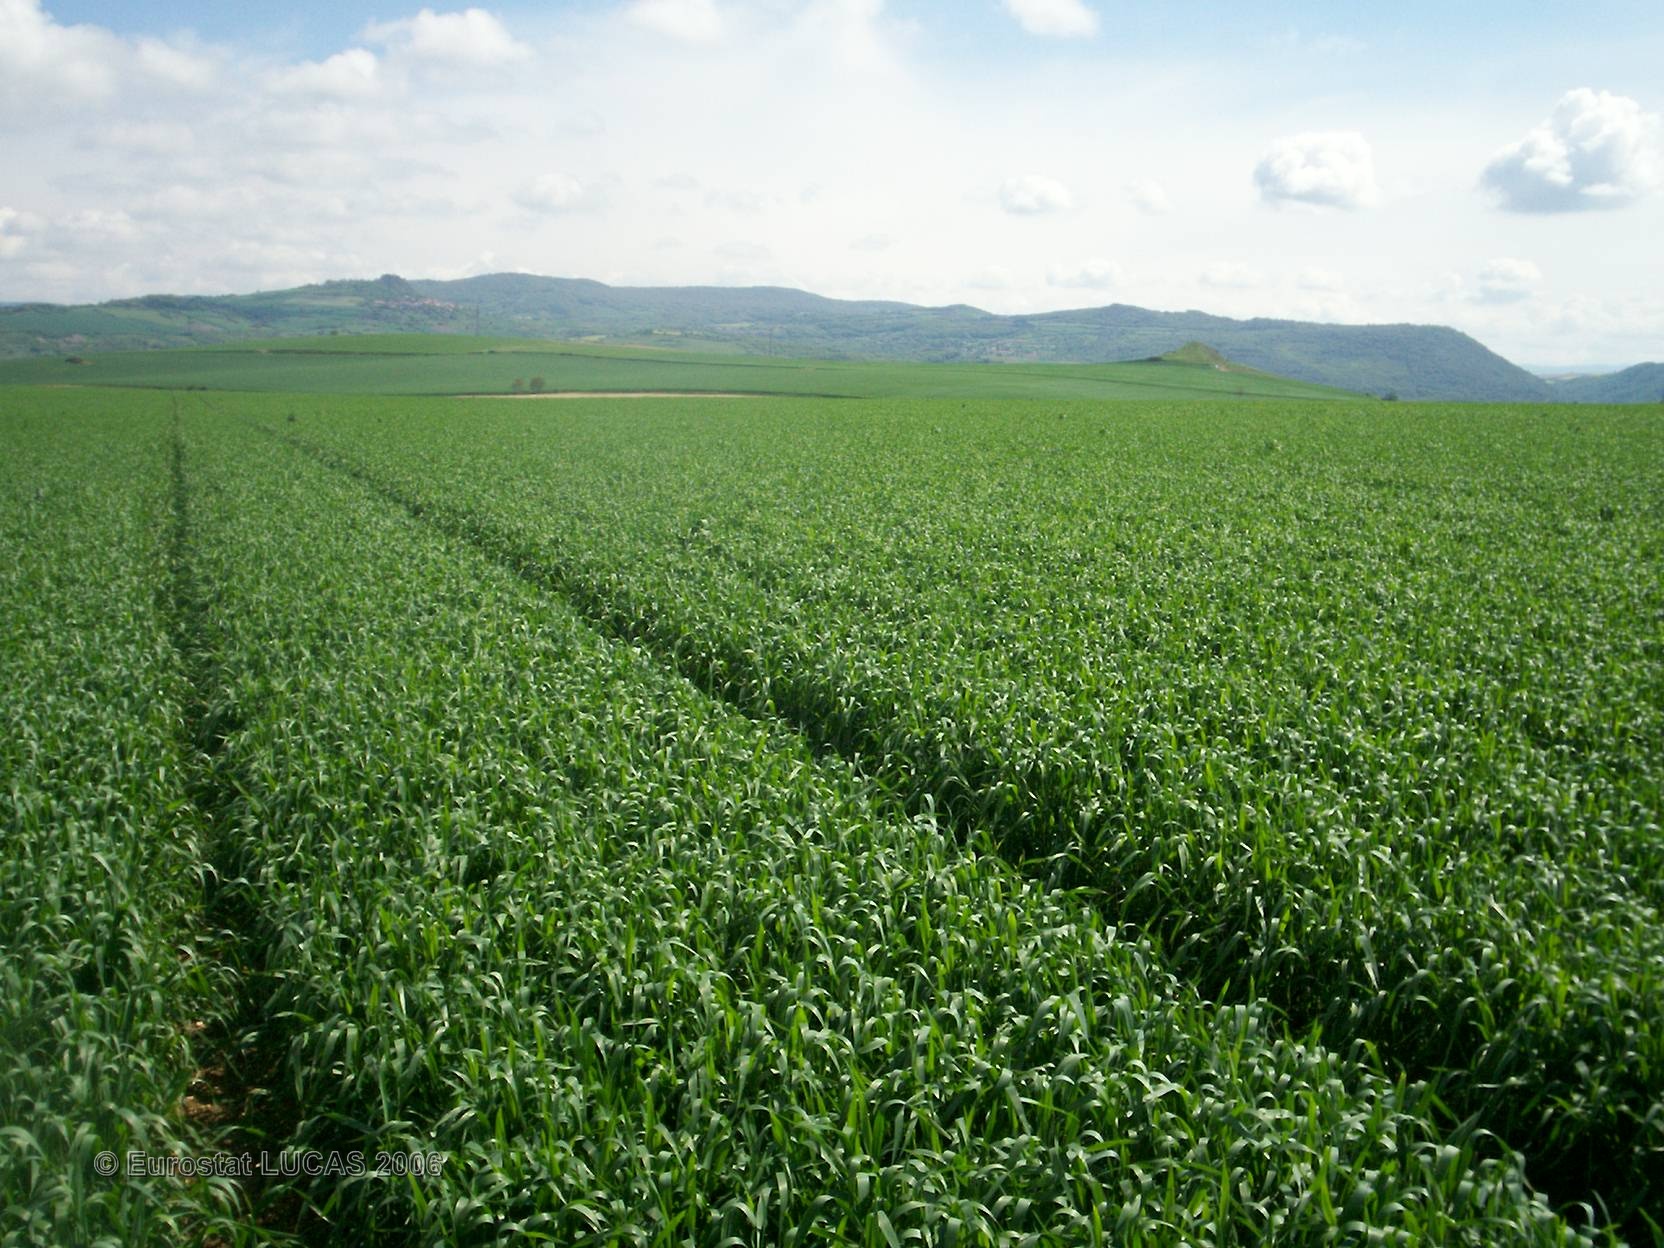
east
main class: Cropland
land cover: Common wheat
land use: Agriculture (excluding fallow land and kitchen gardens)
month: May
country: FR
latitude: 45.5921
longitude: 3.1940
